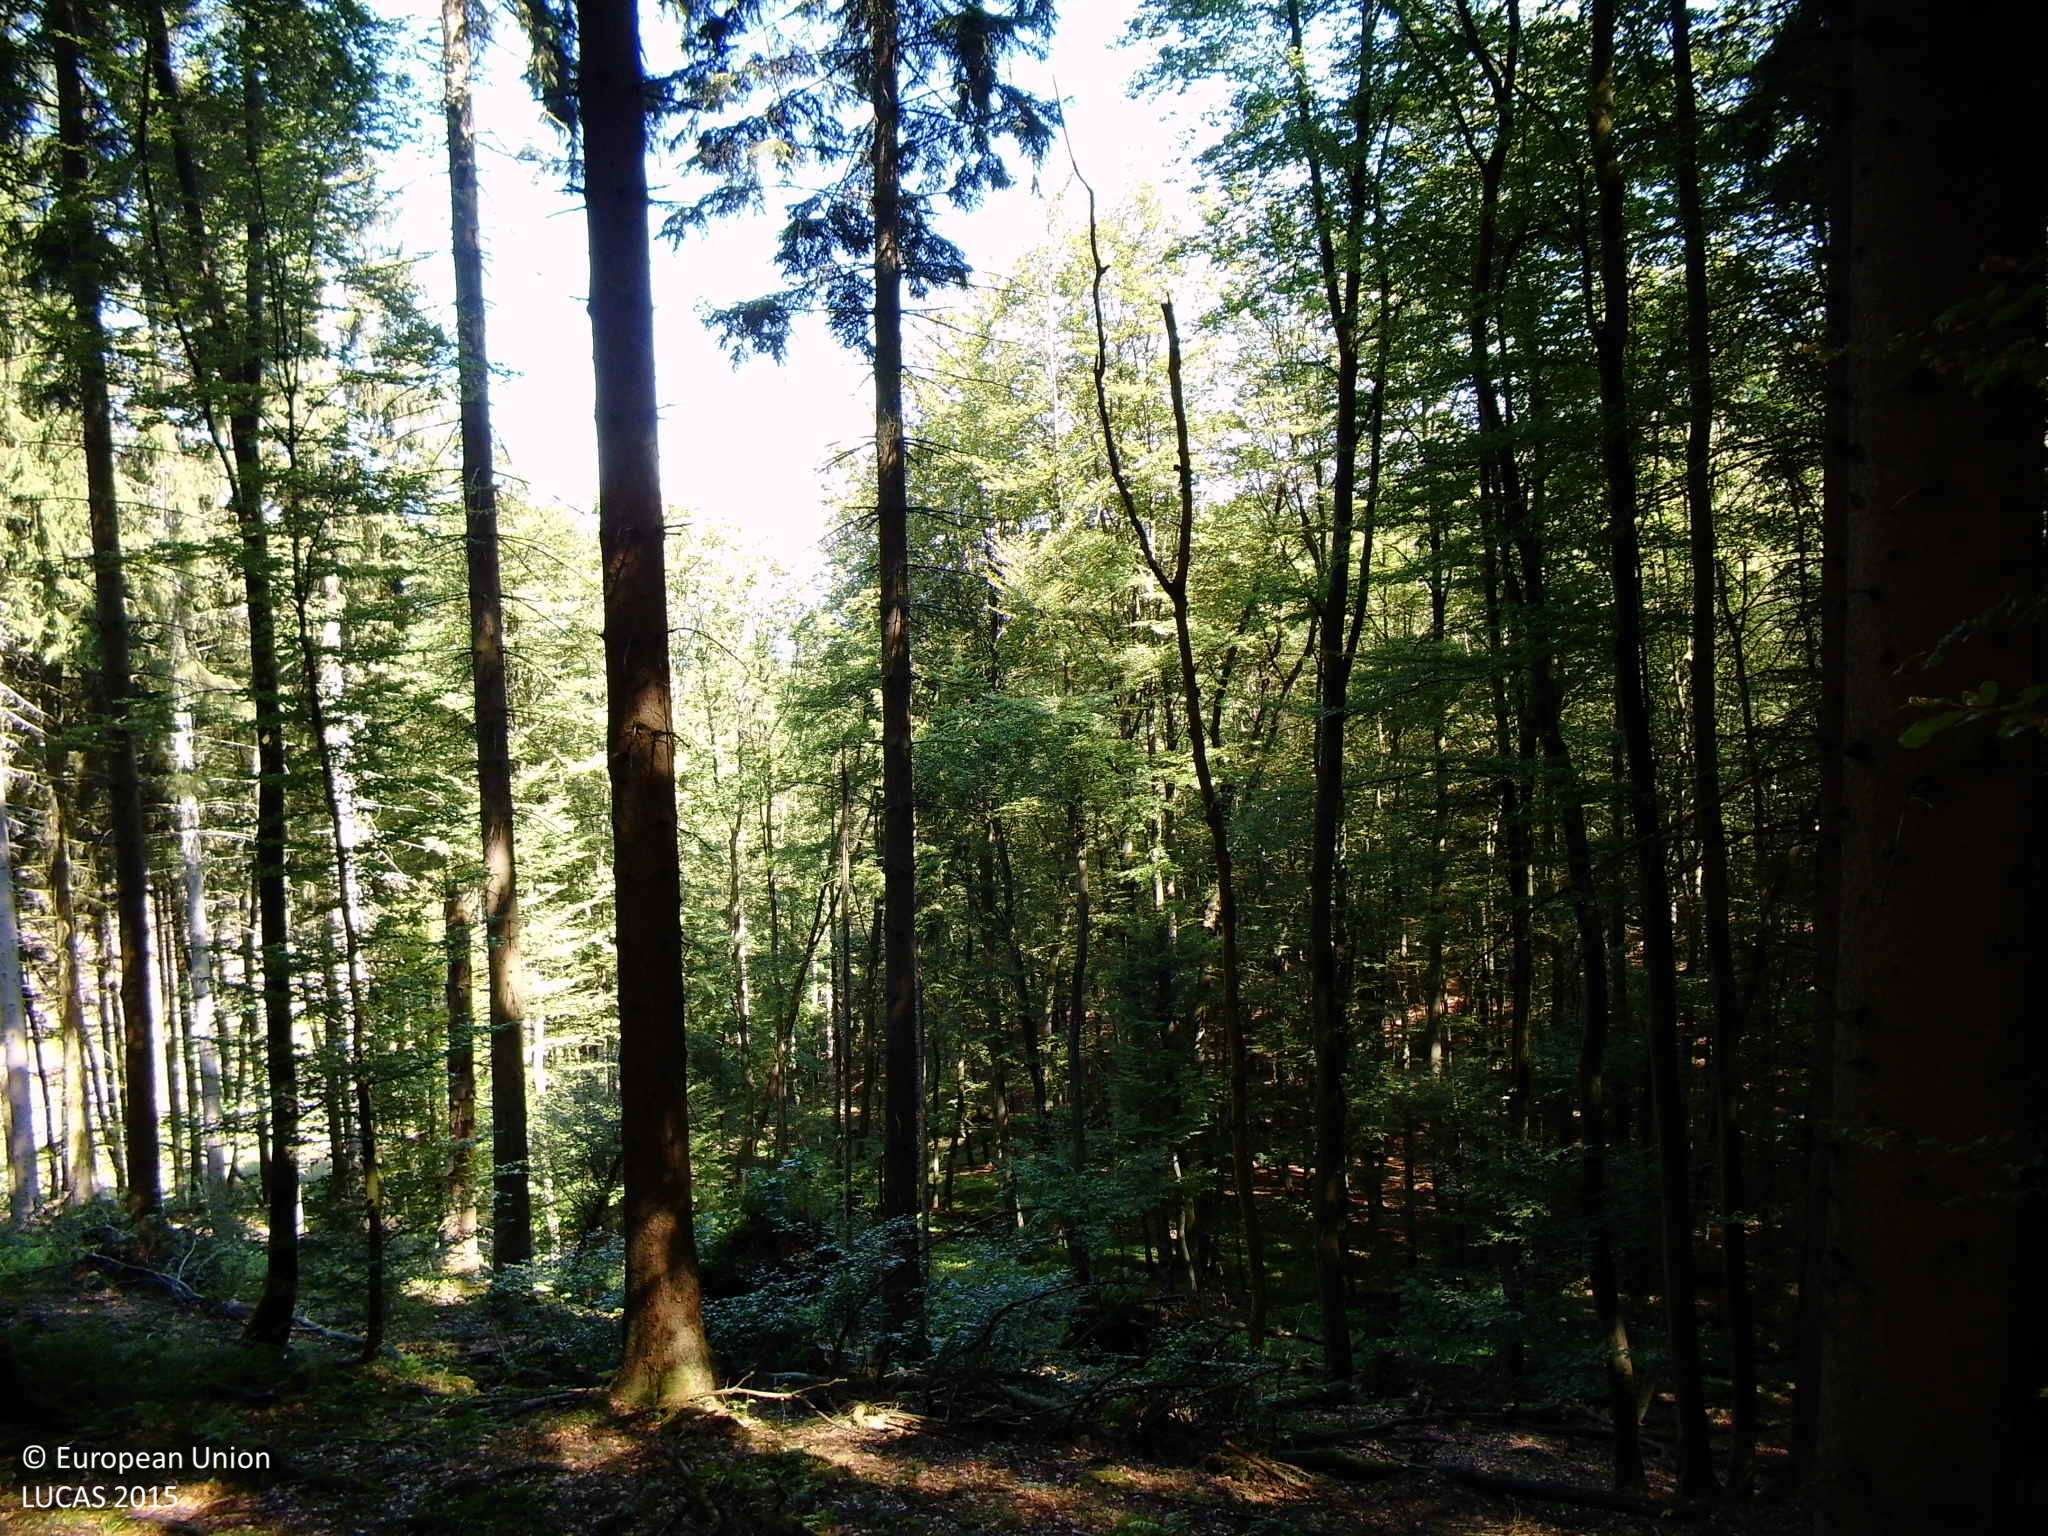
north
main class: Woodland
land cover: Spruce dominated mixed woodland
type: hemiboreal forest and nemoral coniferous forest and mixed broadleaved-coniferous forest
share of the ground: > 75 %
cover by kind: coniferous forest trees 60 %, broadleaved forest trees 25 %, herbaceous plants 5 %, lichens and mosses 5 %, unconsolidated bare surface 5 %
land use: Forestry
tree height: > 5 m
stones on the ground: < 10 %
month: August
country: DE
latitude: 51.1022
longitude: 8.0153
